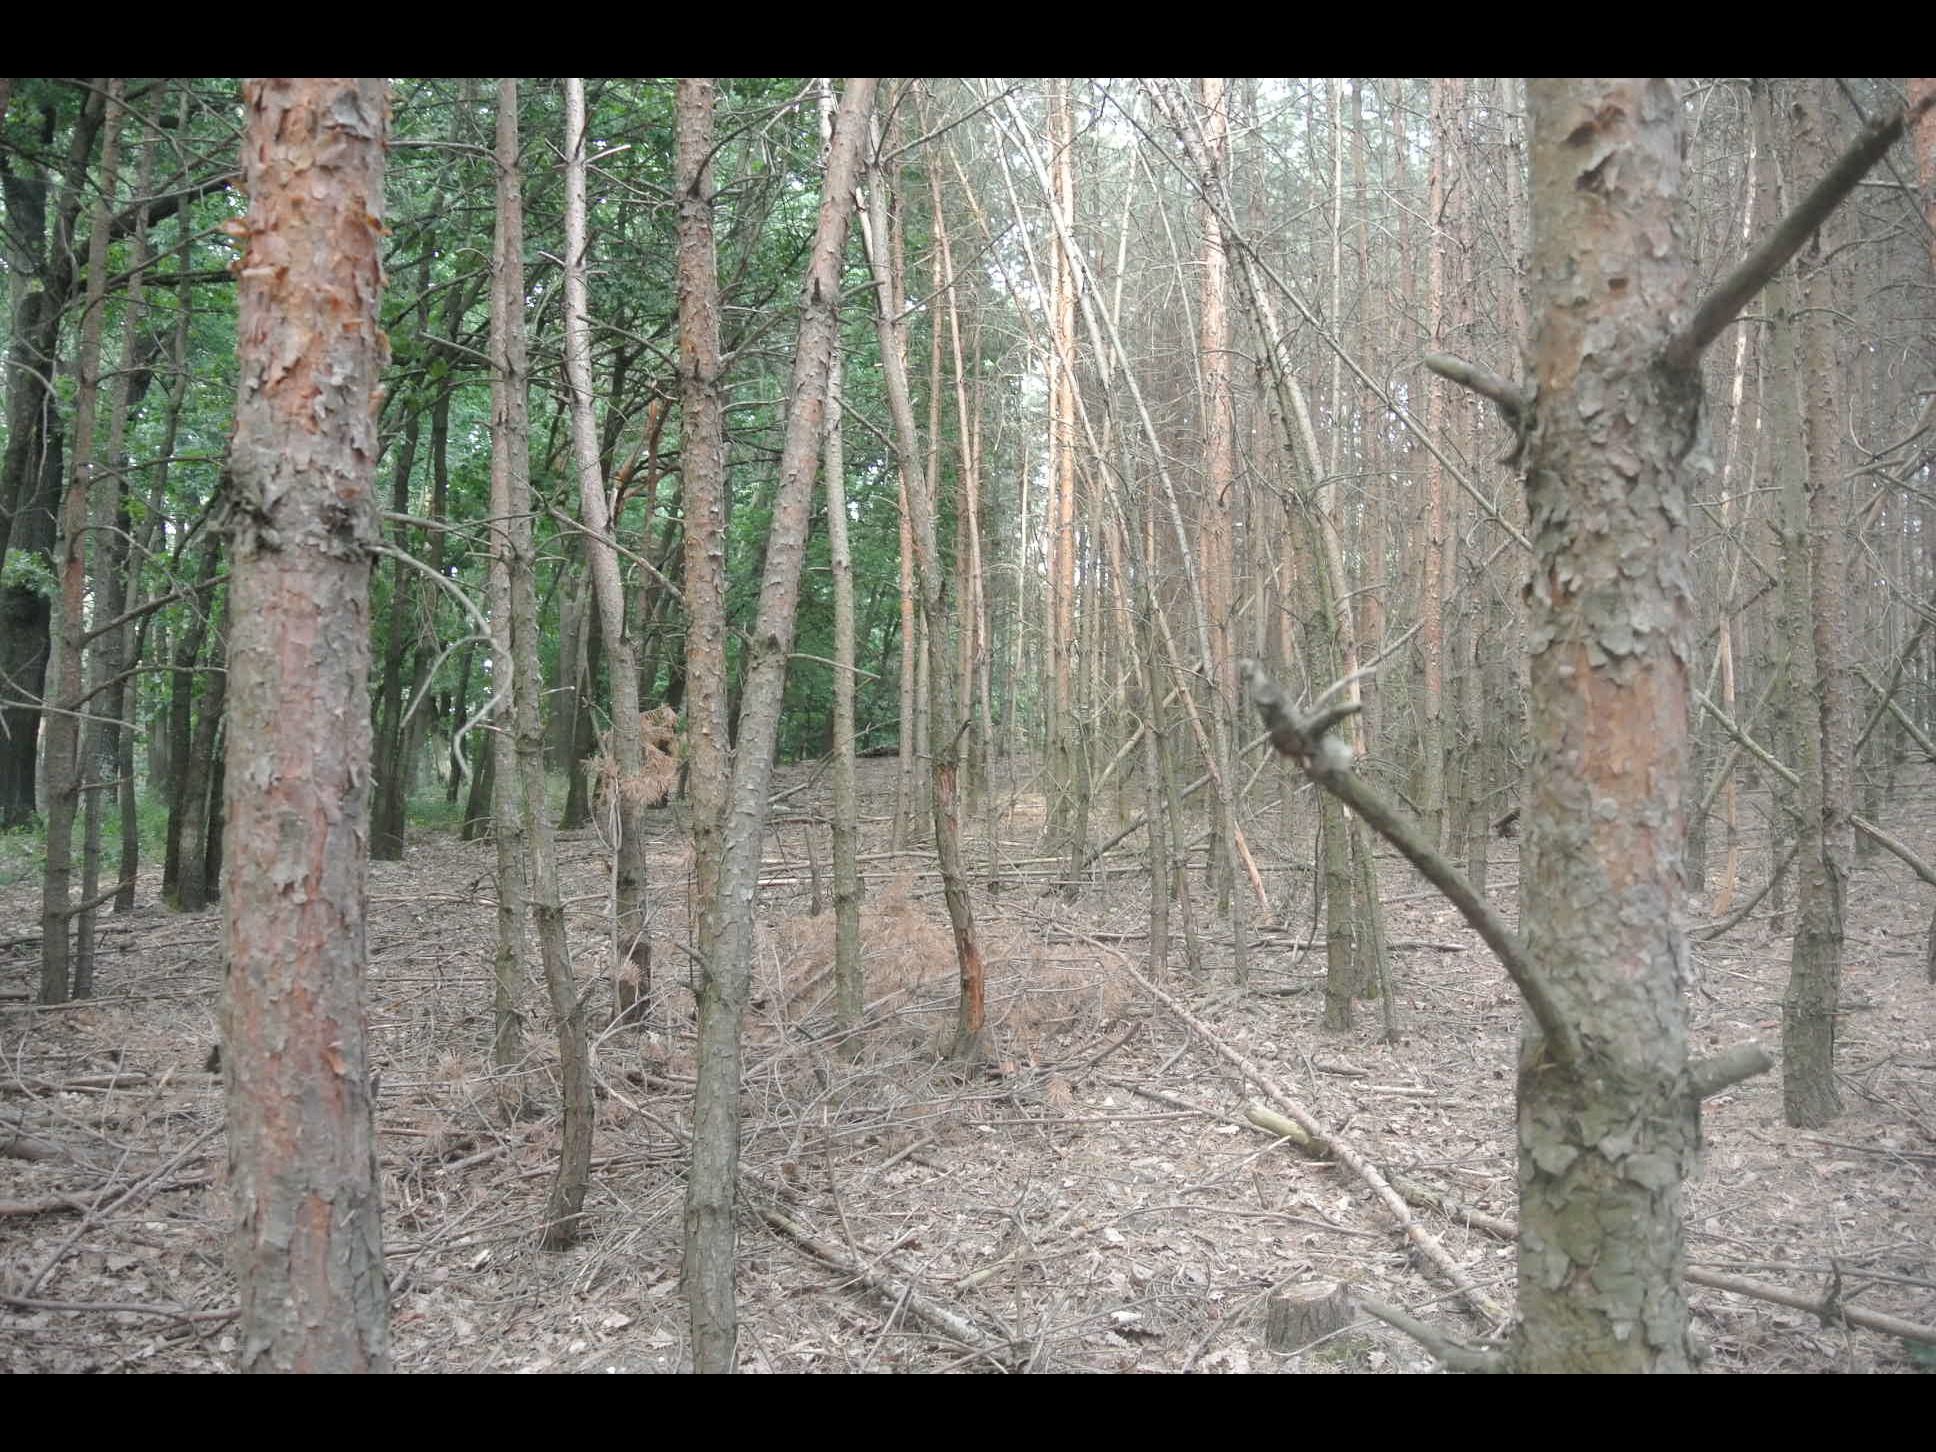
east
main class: Woodland
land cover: Pine dominated coniferous woodland
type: alpine coniferous forest
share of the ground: > 75 %
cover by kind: coniferous forest trees 90 %, unconsolidated bare surface 10 %
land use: Forestry
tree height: > 5 m
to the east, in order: Pine dominated coniferous woodland; Spruce dominated coniferous woodland; Broadleaved woodland; Rivers and streams; Pine dominated mixed woodland; Broadleaved woodland; Pine dominated mixed woodland; Clovers
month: July
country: AT
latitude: 47.4429
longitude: 16.3817
